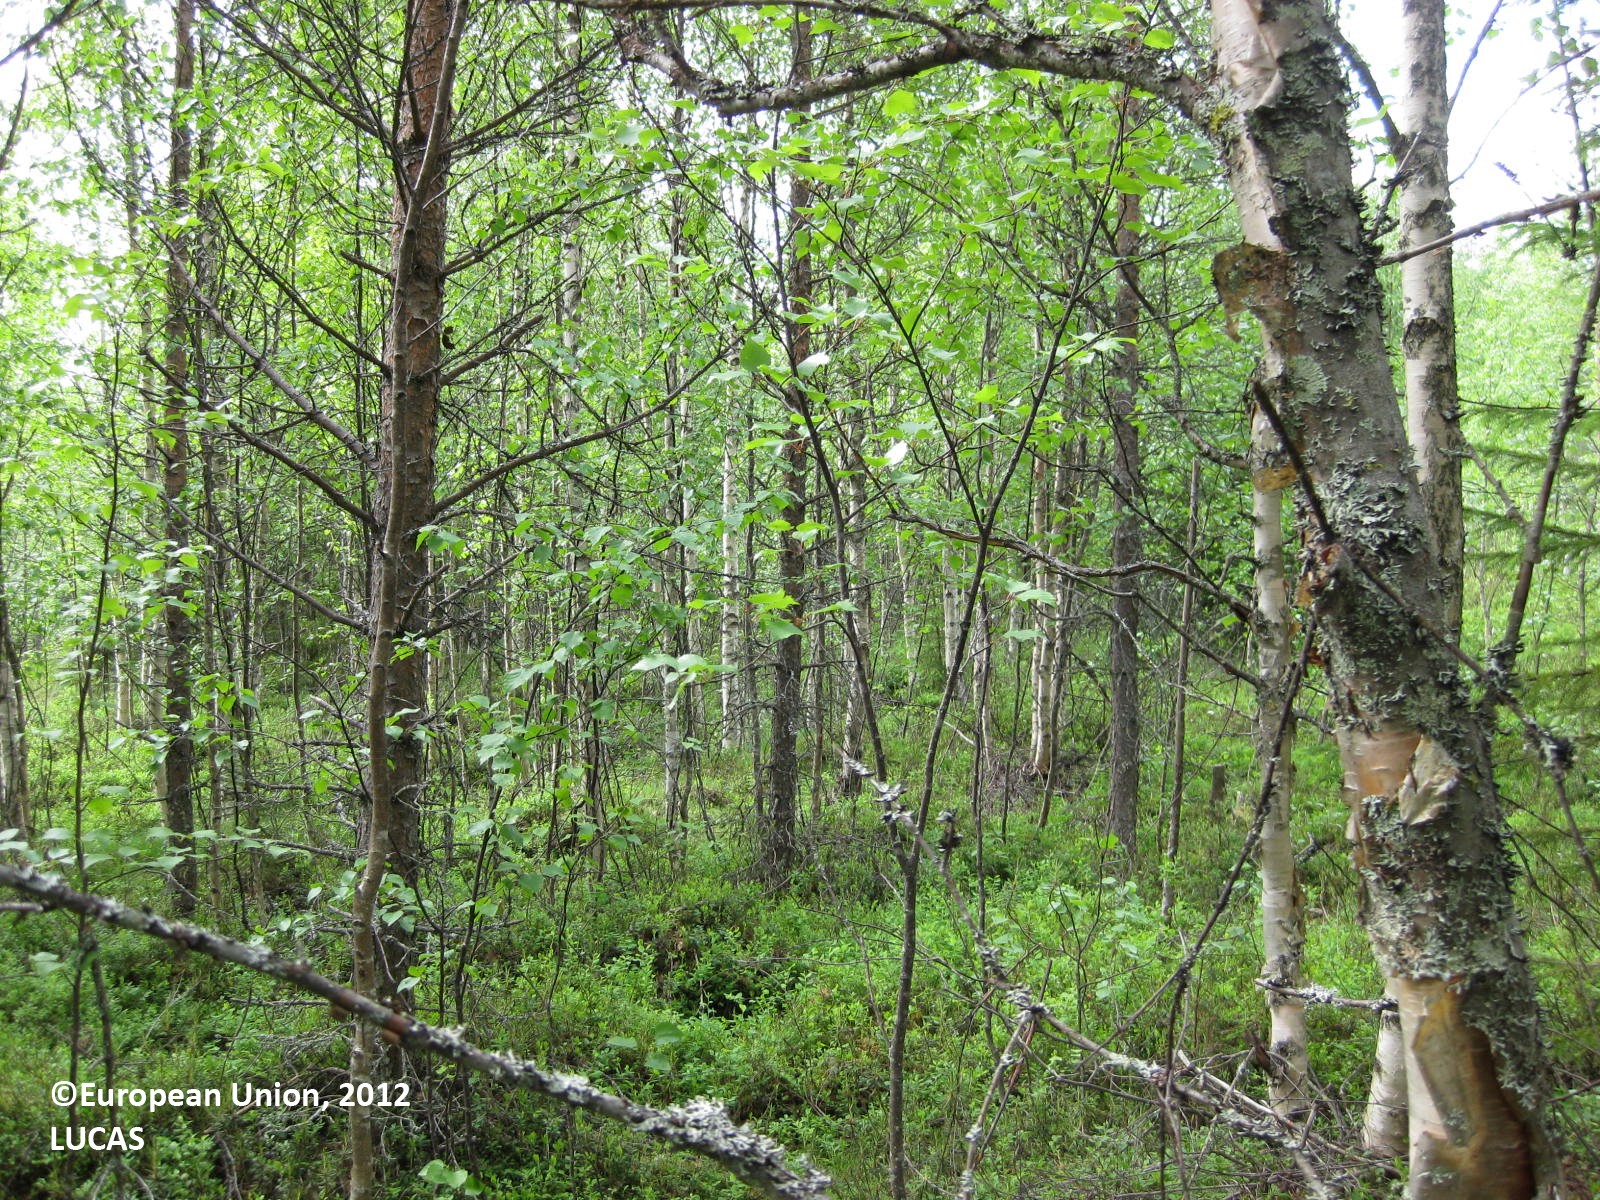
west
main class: Woodland
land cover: Pine dominated mixed woodland
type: boreal forest
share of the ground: > 75 %
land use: Forestry
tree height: > 5 m
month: June
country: FI
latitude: 65.3097
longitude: 28.1980
